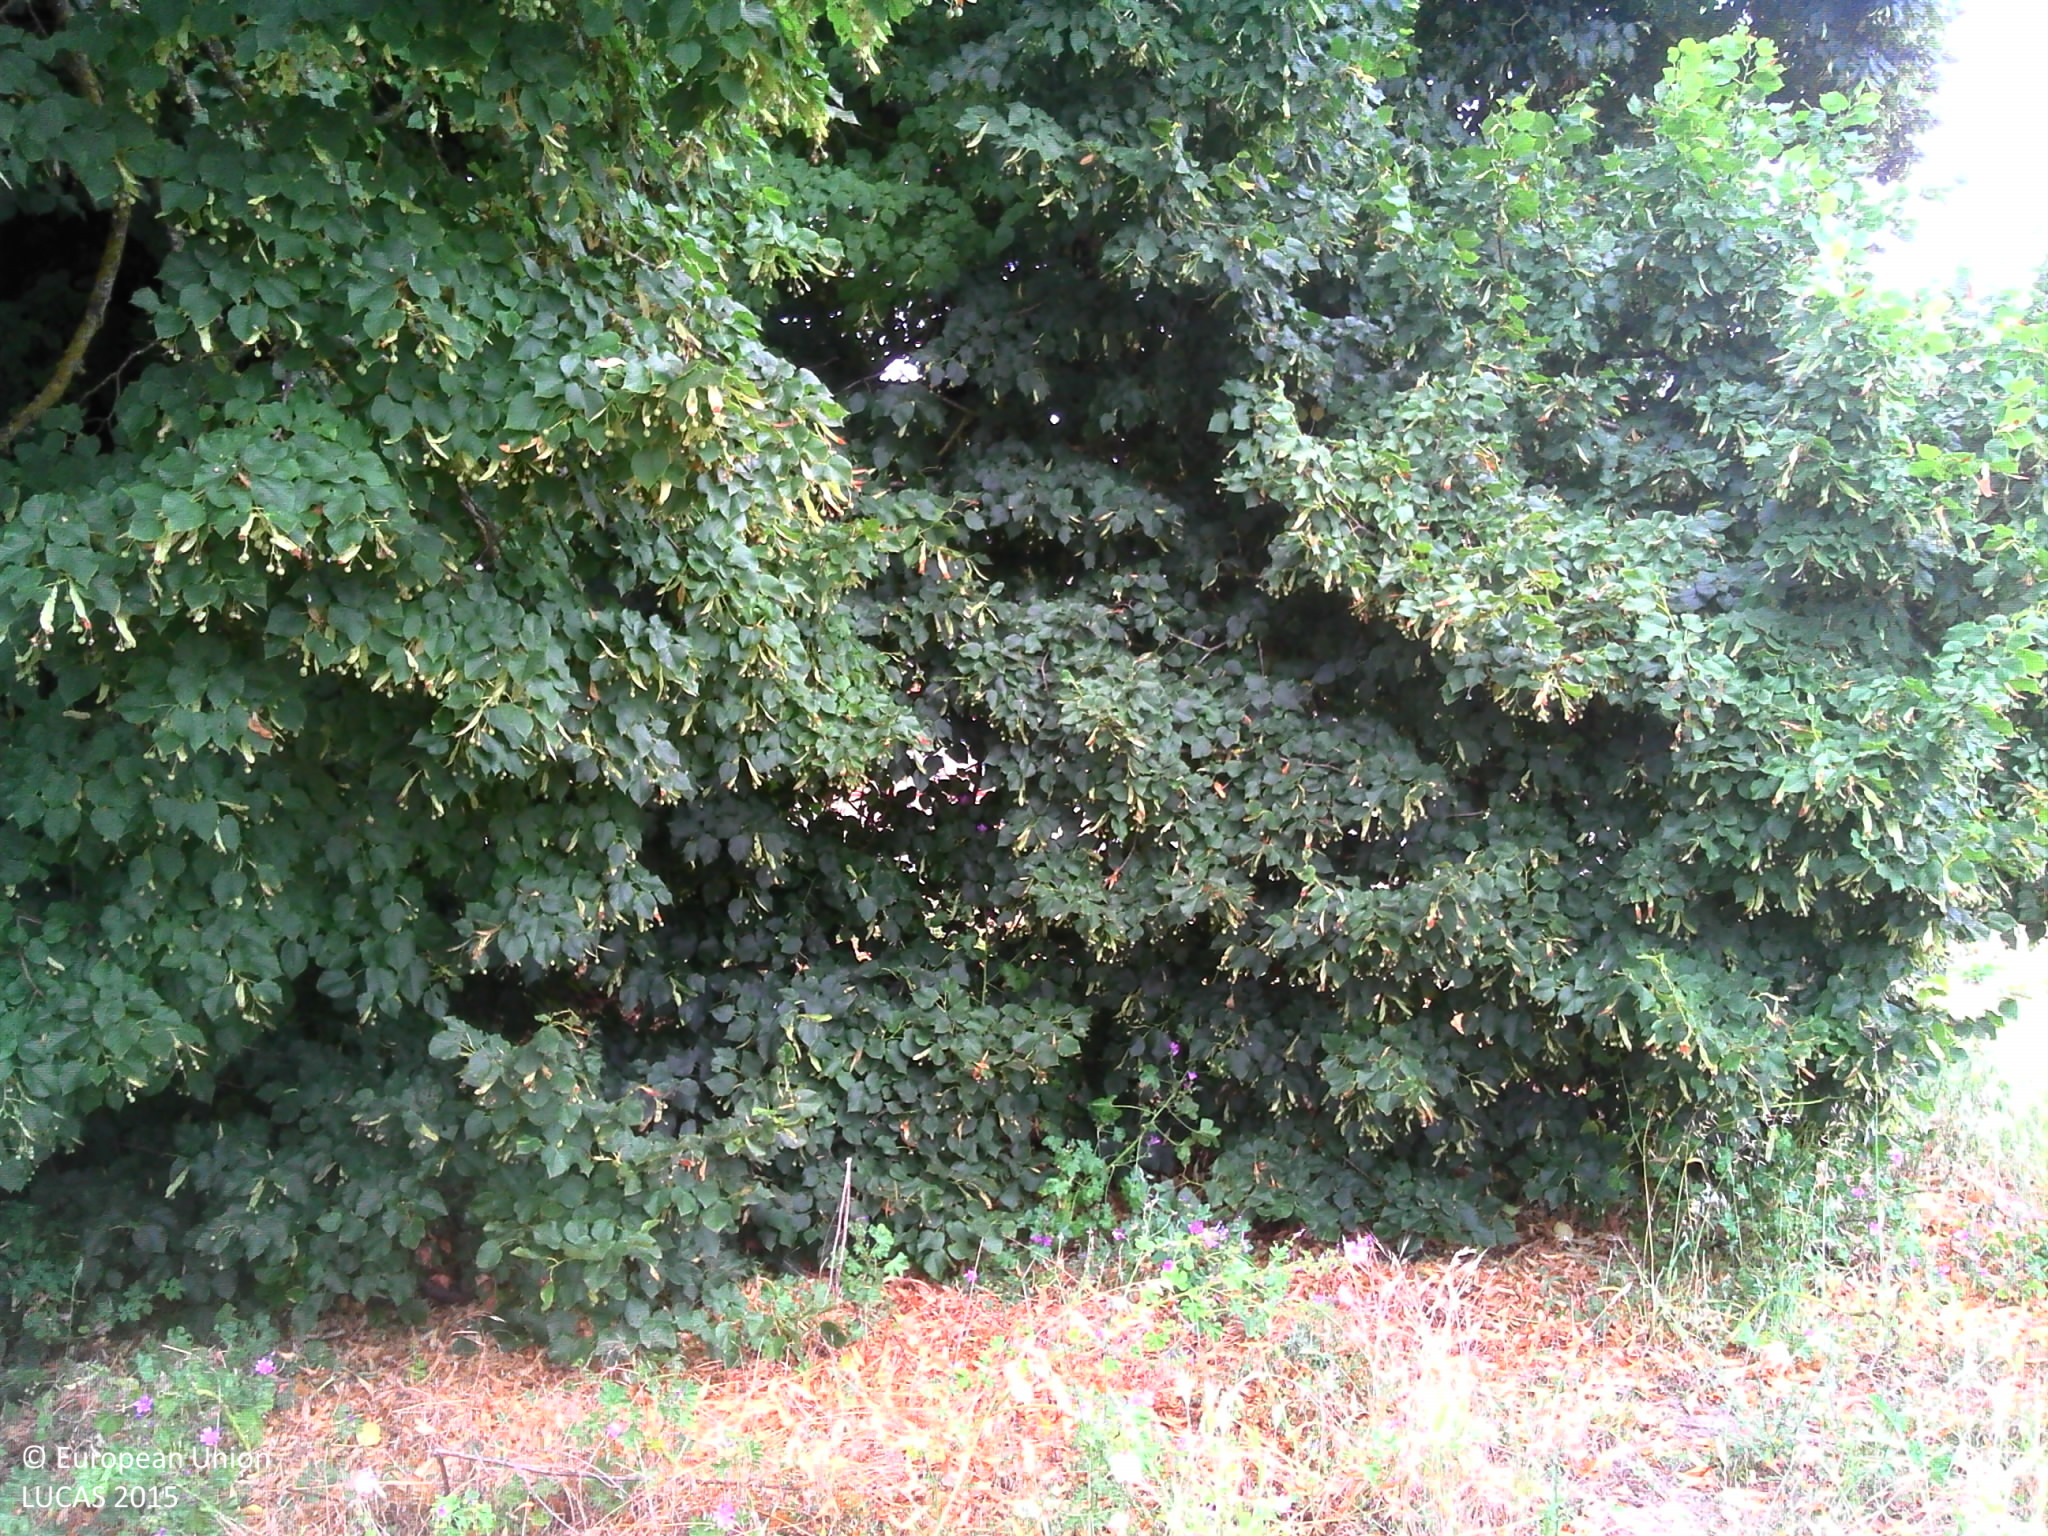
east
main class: Grassland
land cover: Grassland without tree/shrub cover
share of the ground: > 75 %
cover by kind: herbaceous plants 100 %
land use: Agriculture (excluding fallow land and kitchen gardens)
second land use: Residential
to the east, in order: Grassland without tree/shrub cover; Abandoned hedges; Artificial constructions in urban areas; Common wheat; Electric lines; Common wheat; Fences; Grassland without tree/shrub cover
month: July
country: FR
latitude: 47.3265
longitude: 0.3318
